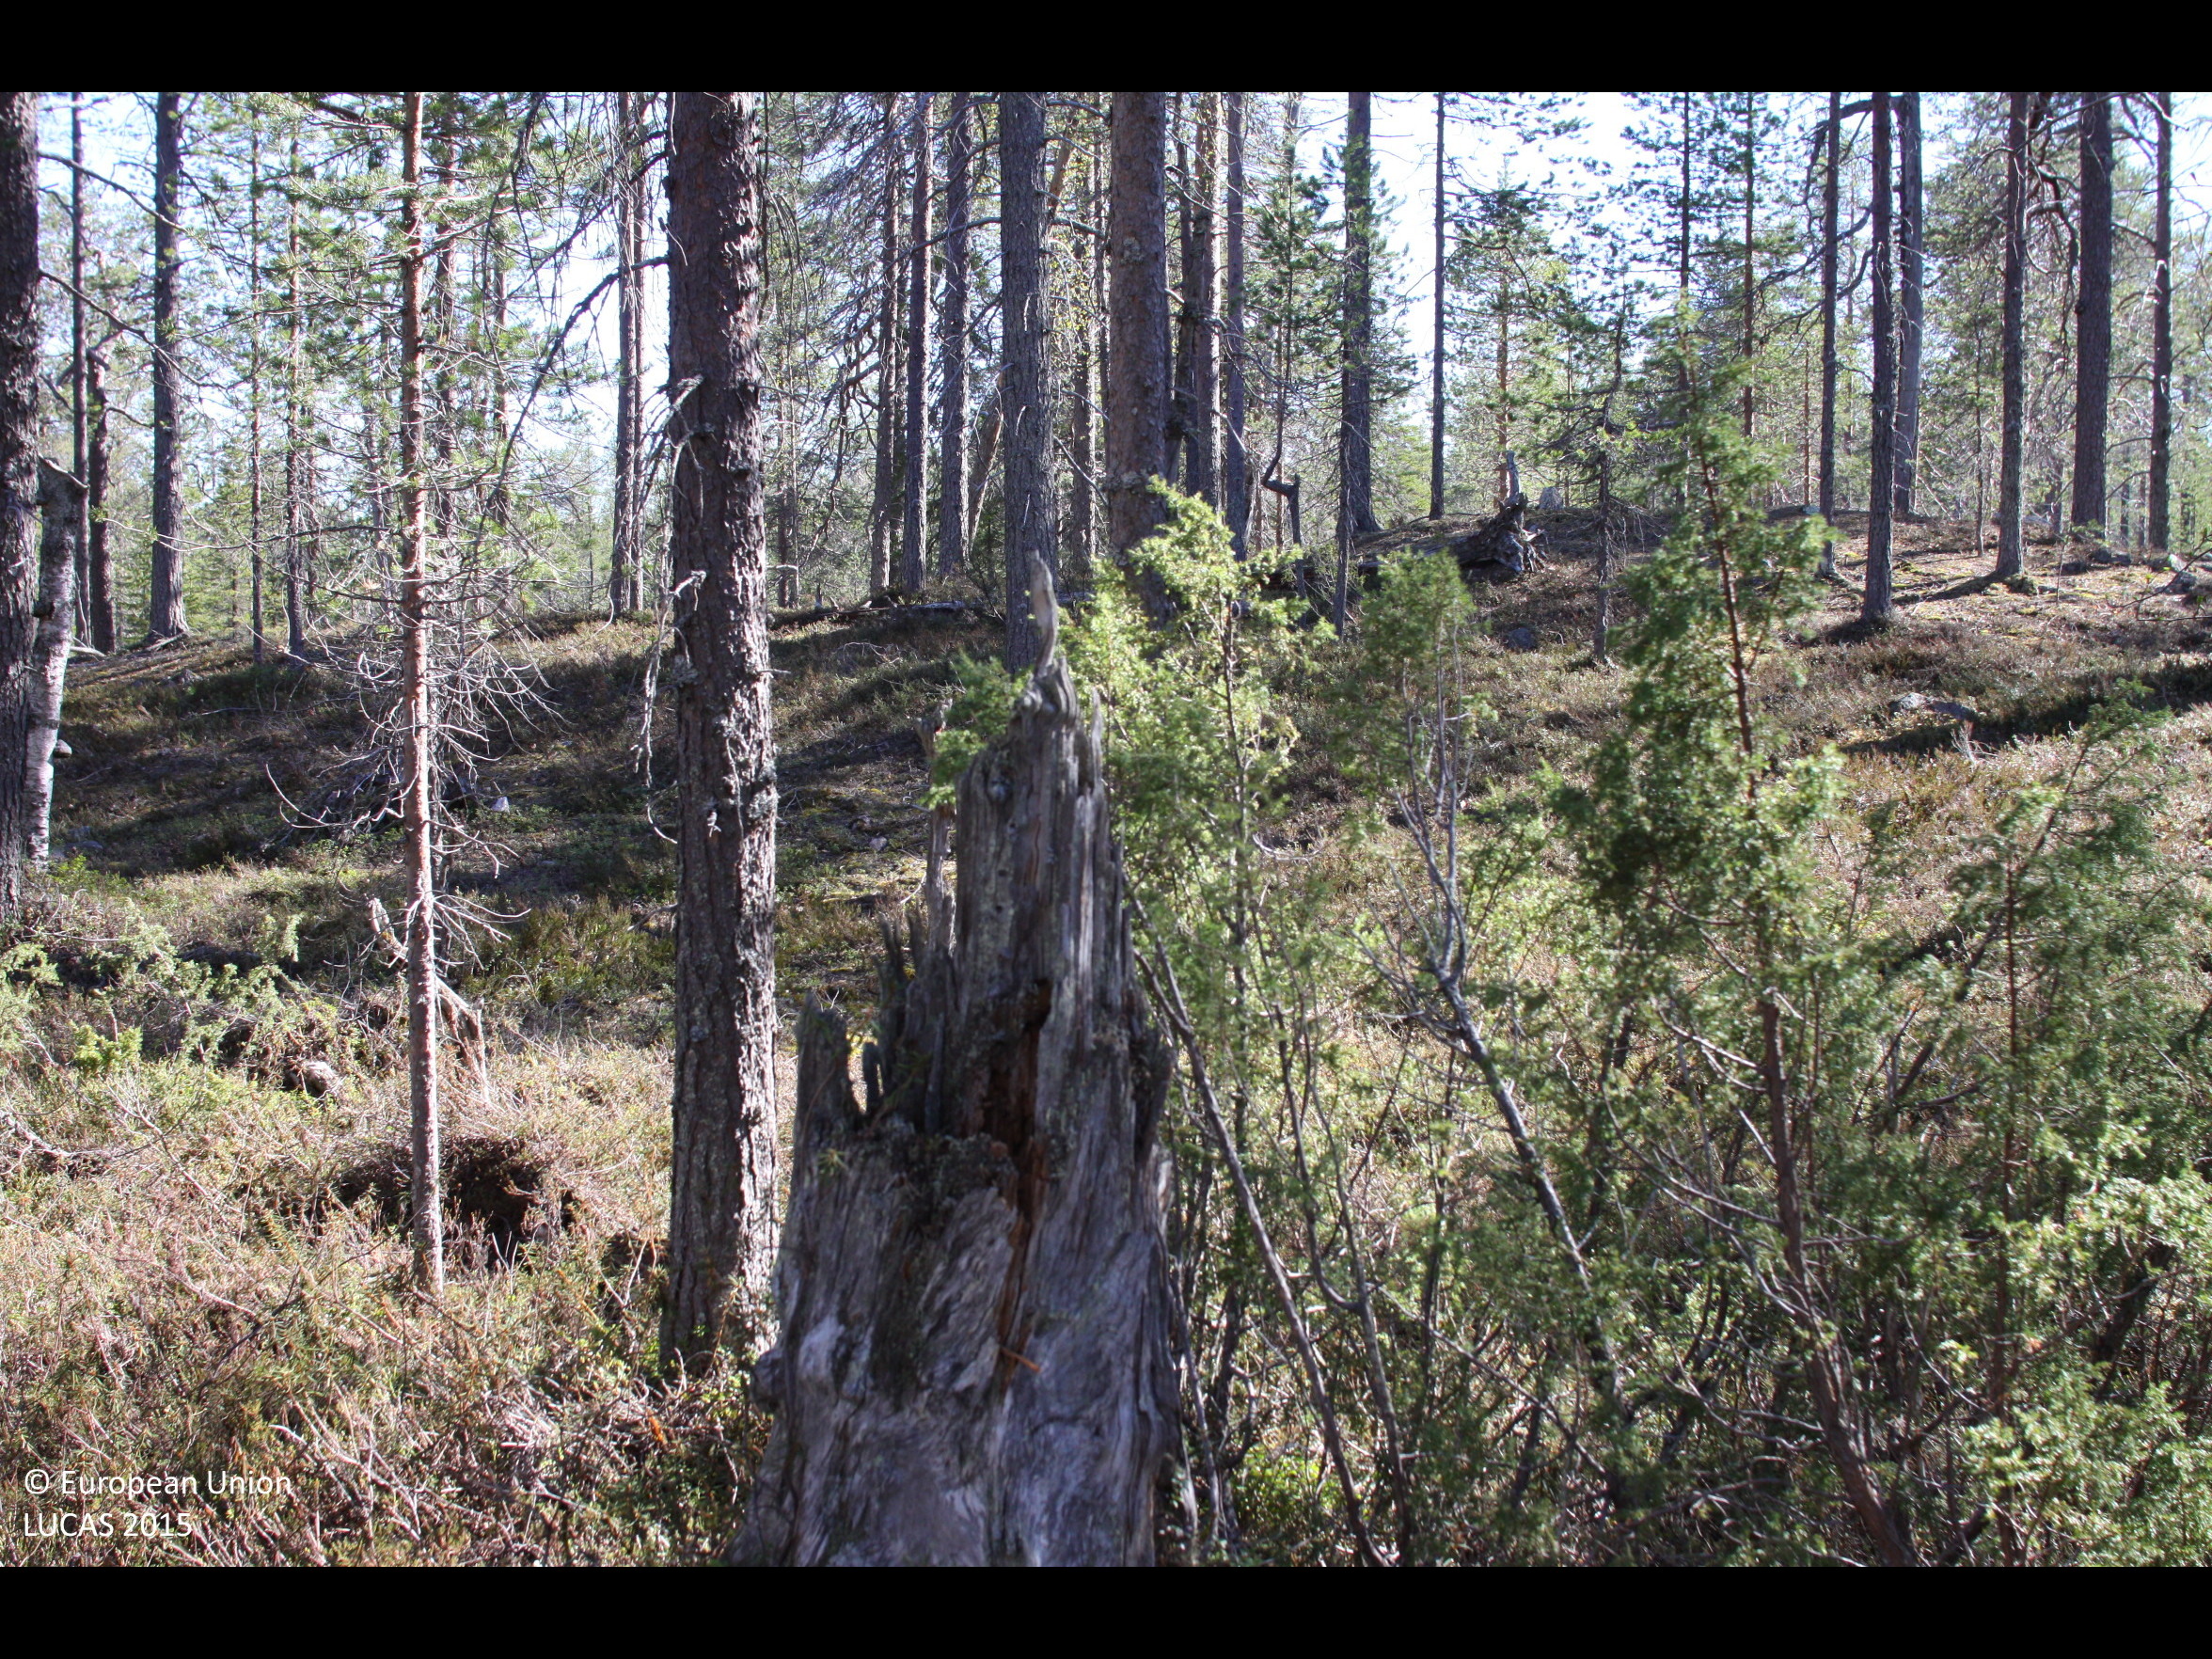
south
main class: Woodland
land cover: Pine dominated coniferous woodland
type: boreal forest
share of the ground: > 75 %
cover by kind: coniferous forest trees 80 %, shrubs 20 %
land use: Forestry
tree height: > 5 m
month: June
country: FI
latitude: 66.2765
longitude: 27.5605
